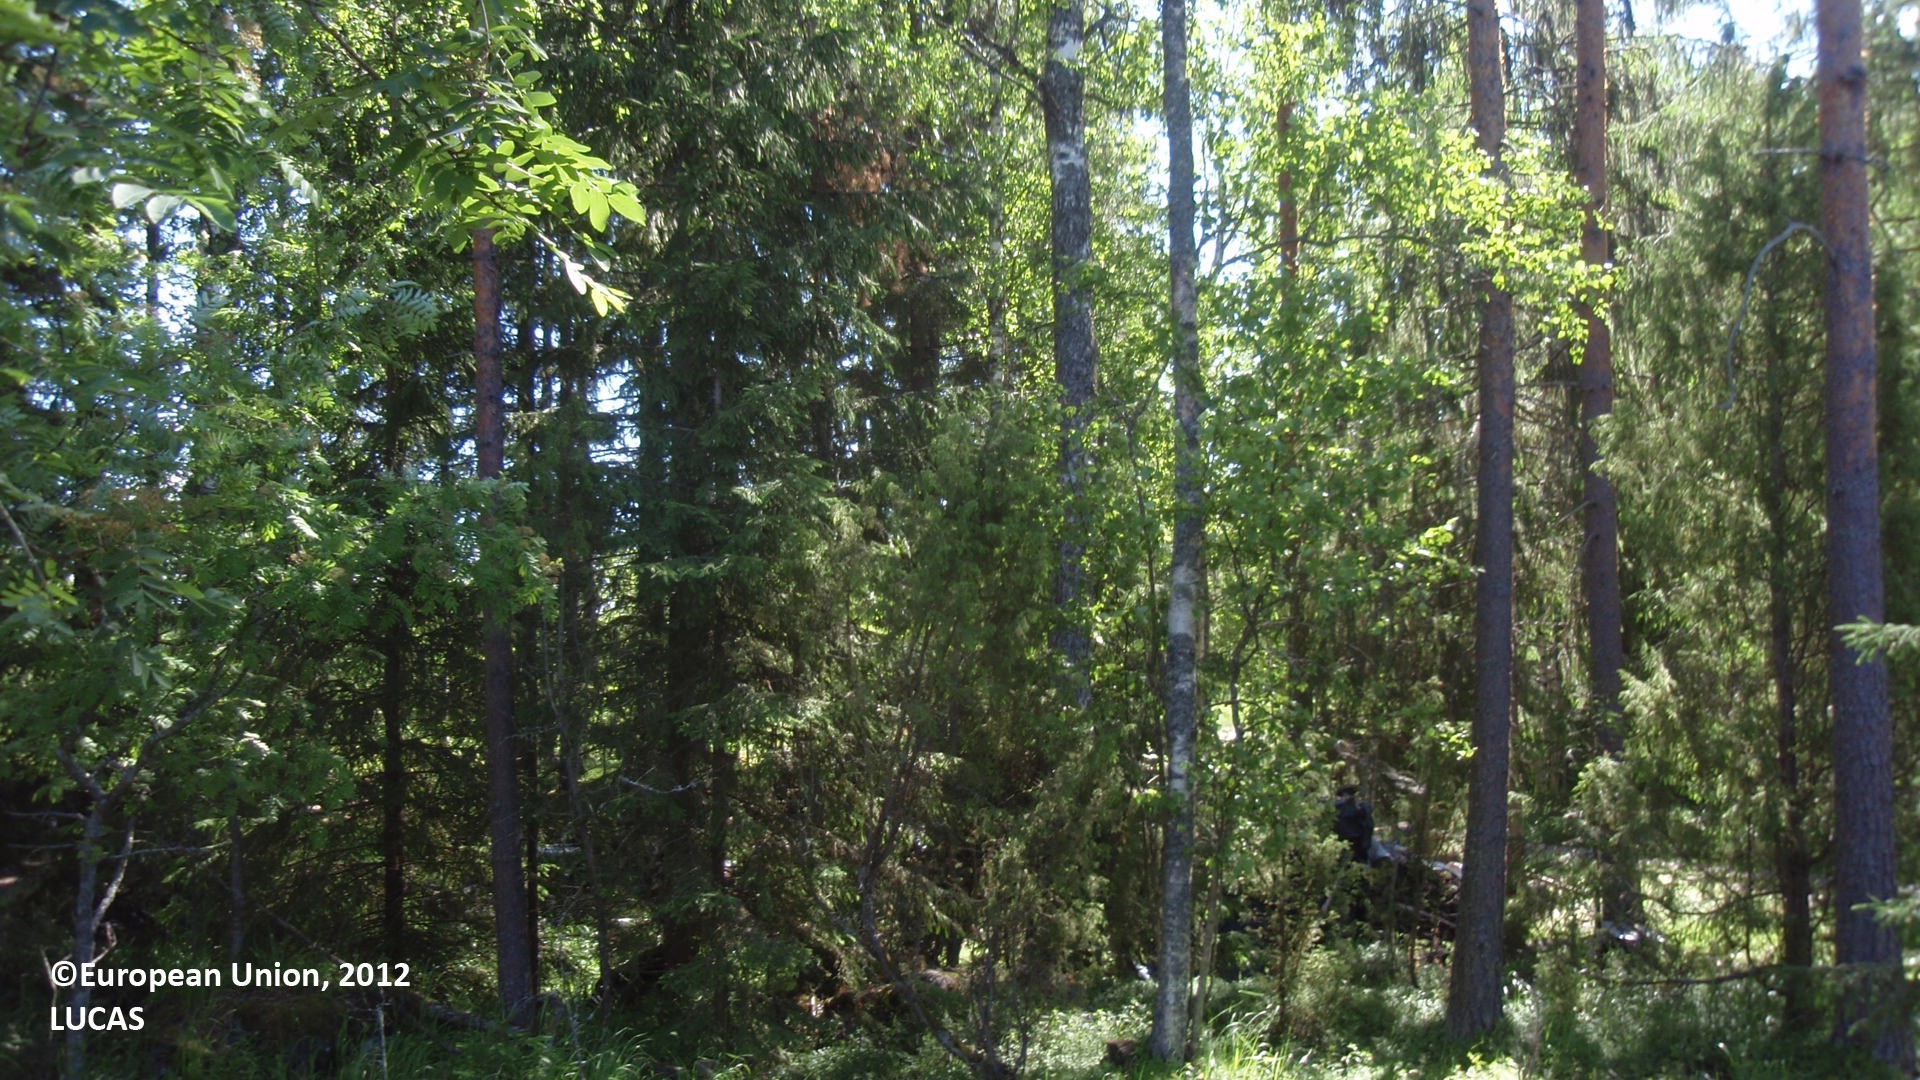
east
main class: Grassland
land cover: Grassland with sparse tree/shrub cover
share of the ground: > 75 %
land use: Logistics and storage
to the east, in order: Grassland with sparse tree/shrub cover; Spruce dominated mixed woodland; Grassland with sparse tree/shrub cover; Spruce dominated coniferous woodland
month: June
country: FI
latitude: 61.4674
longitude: 26.8416
